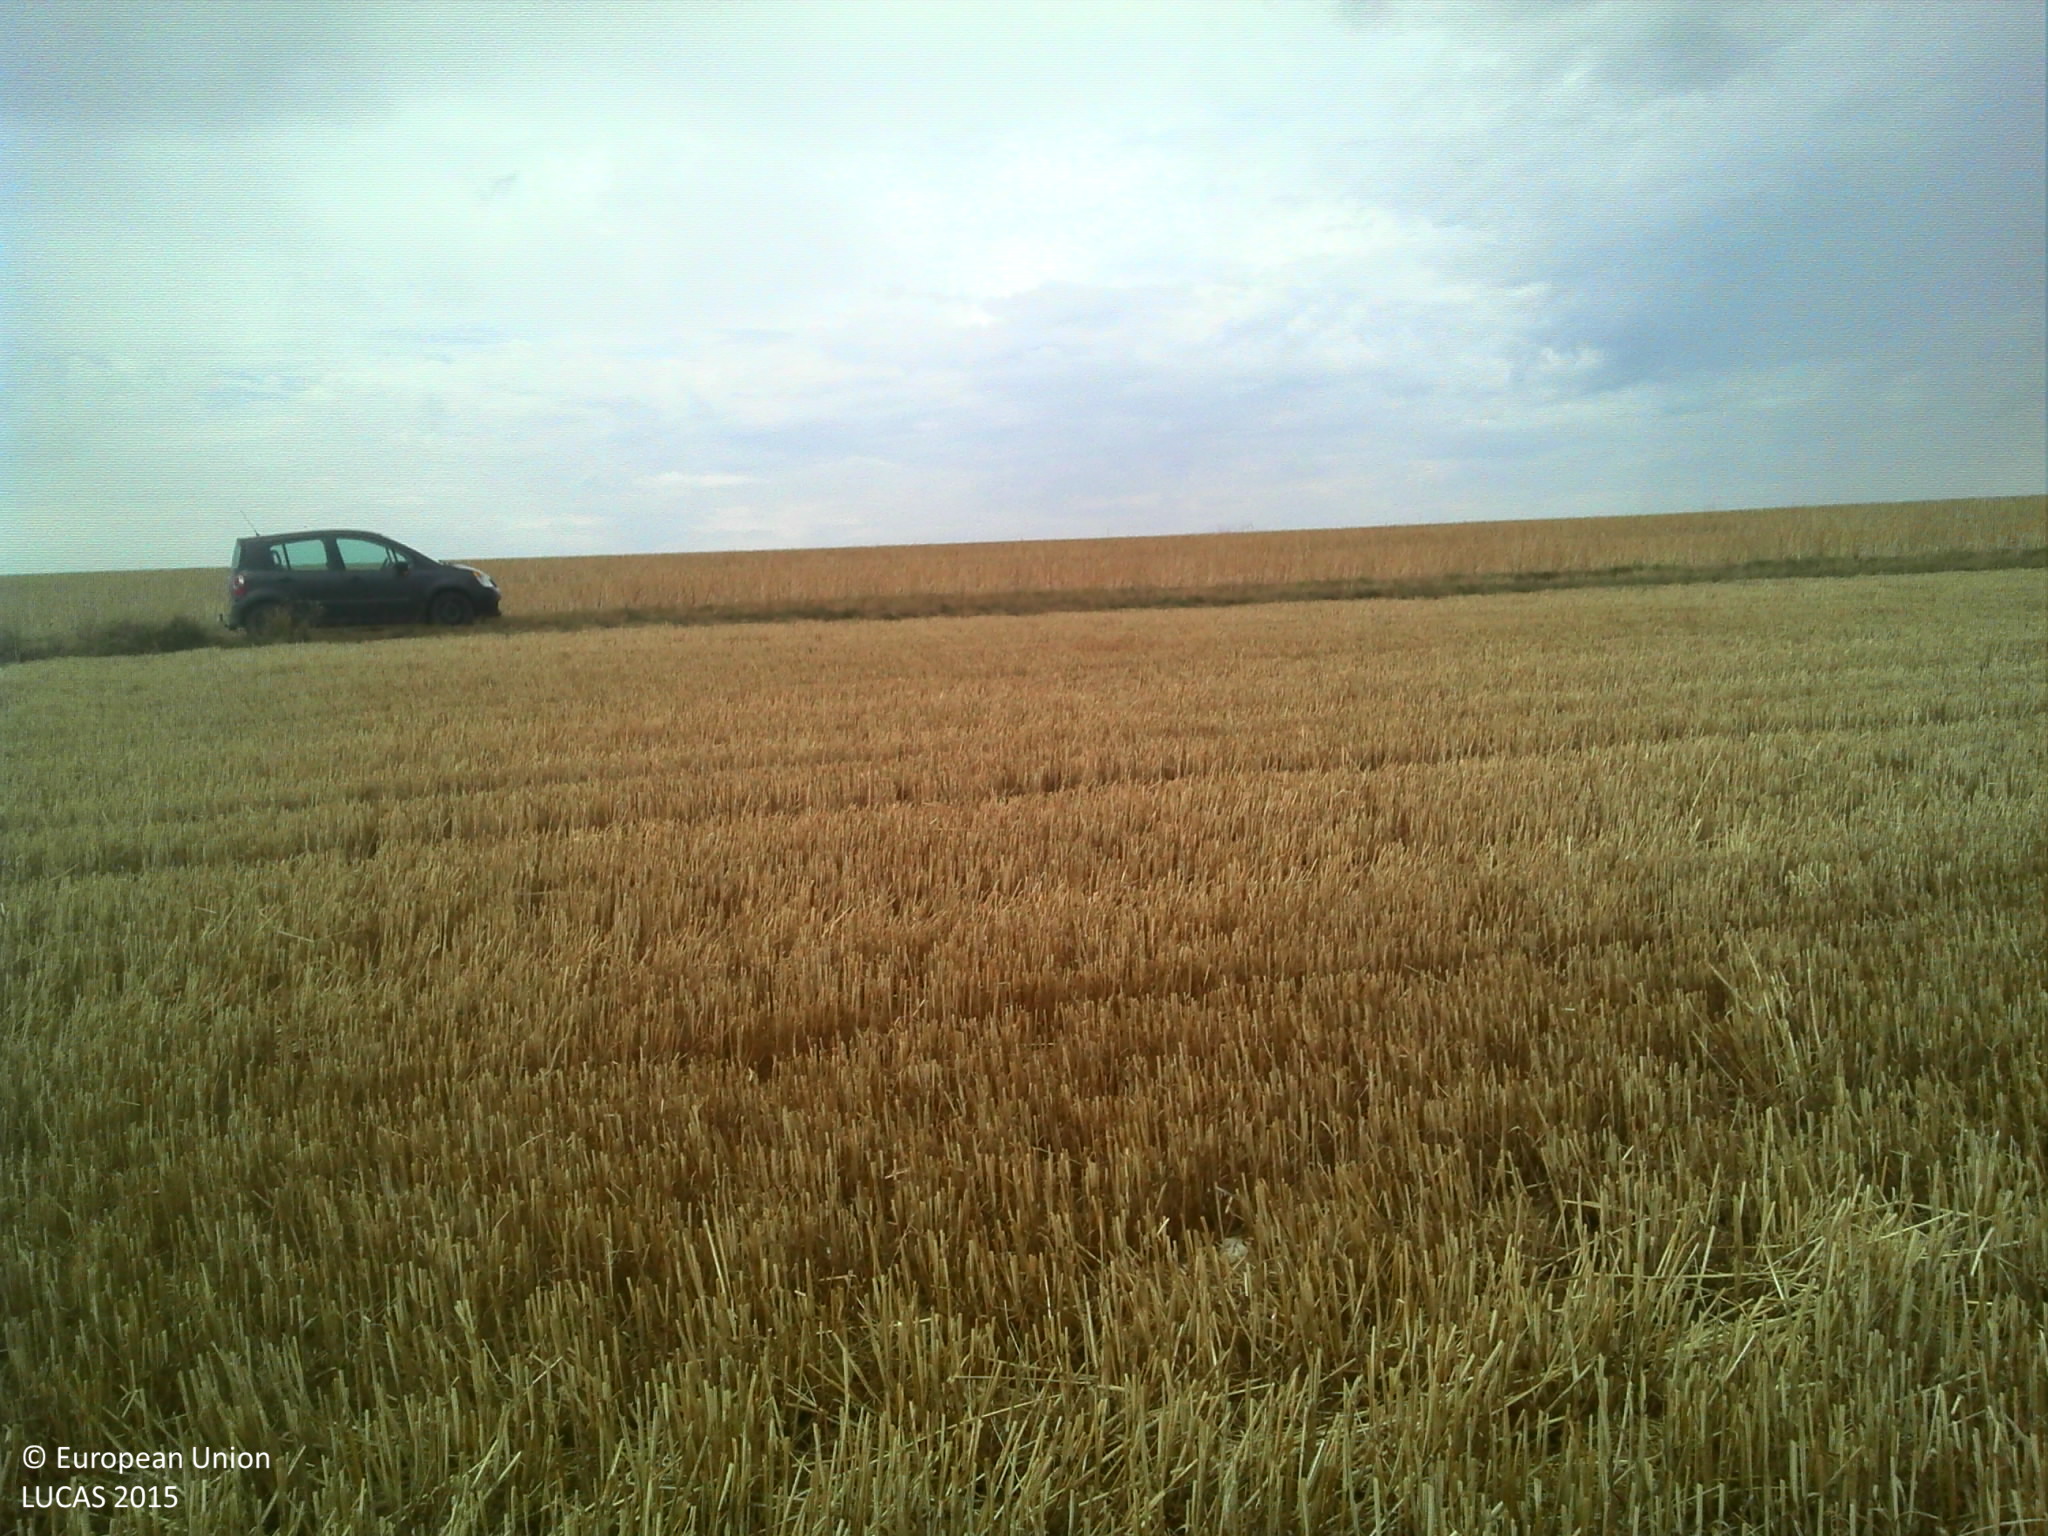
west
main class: Cropland
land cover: Common wheat
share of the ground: 10 - 25 %
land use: Agriculture (excluding fallow land and kitchen gardens)
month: July
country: FR
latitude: 47.9912
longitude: 5.1620
